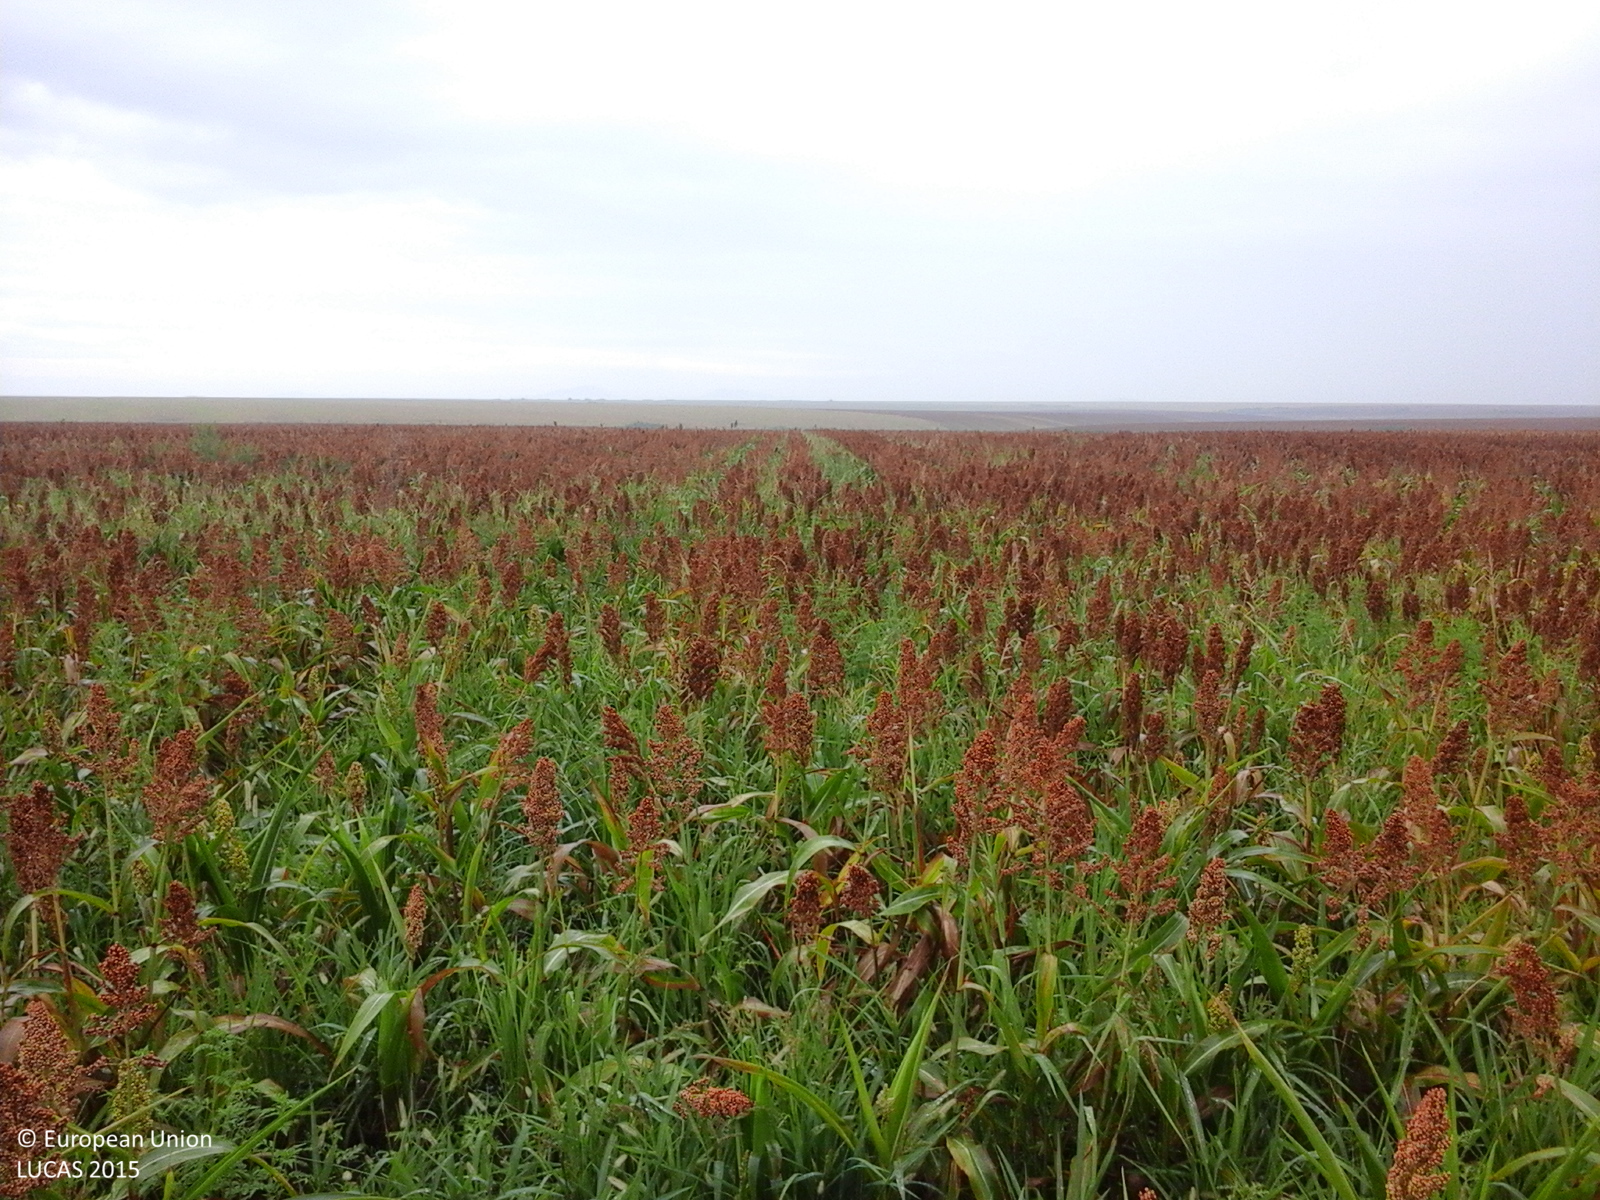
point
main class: Cropland
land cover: Other cereals
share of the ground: > 75 %
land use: Agriculture (excluding fallow land and kitchen gardens)
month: August
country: RO
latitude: 45.4762
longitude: 21.4810
